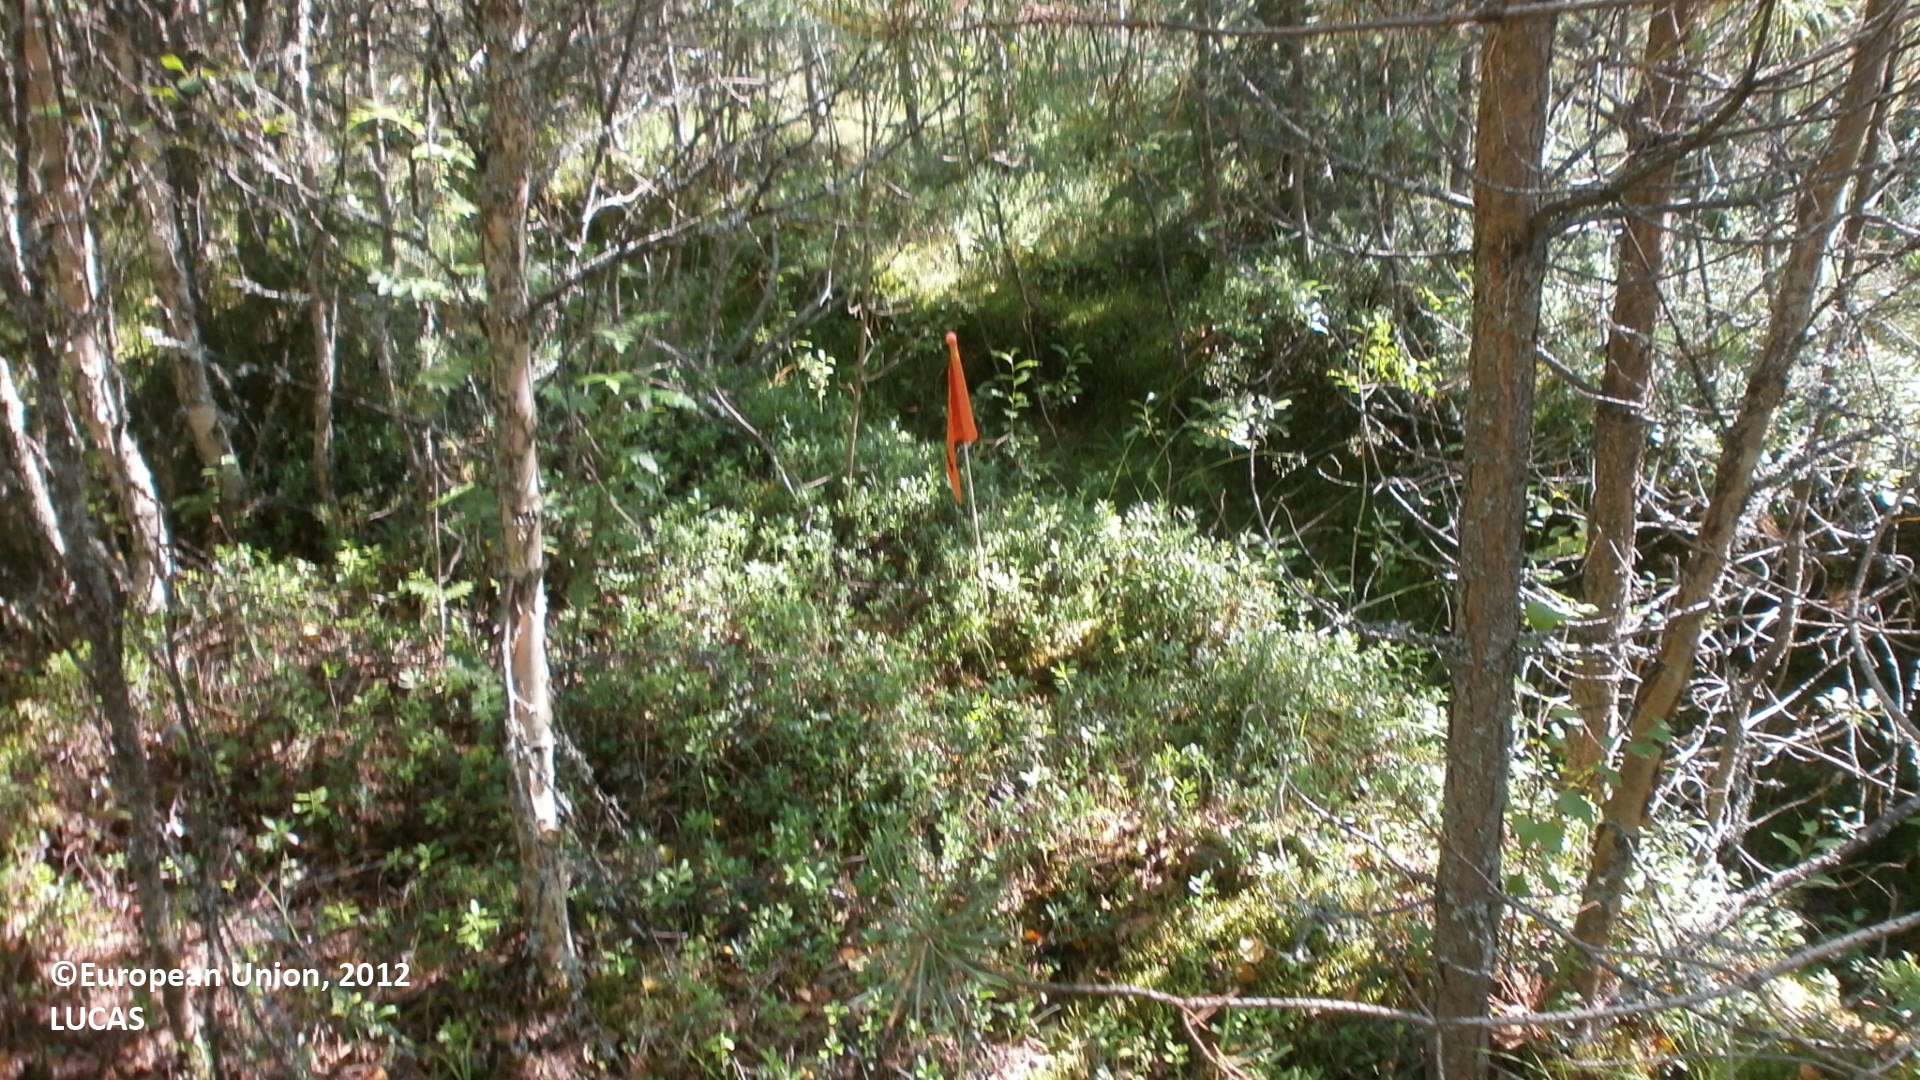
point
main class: Woodland
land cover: Pine dominated mixed woodland
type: boreal forest
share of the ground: > 75 %
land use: Forestry
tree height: > 5 m
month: July
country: FI
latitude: 64.1296
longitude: 23.9280
